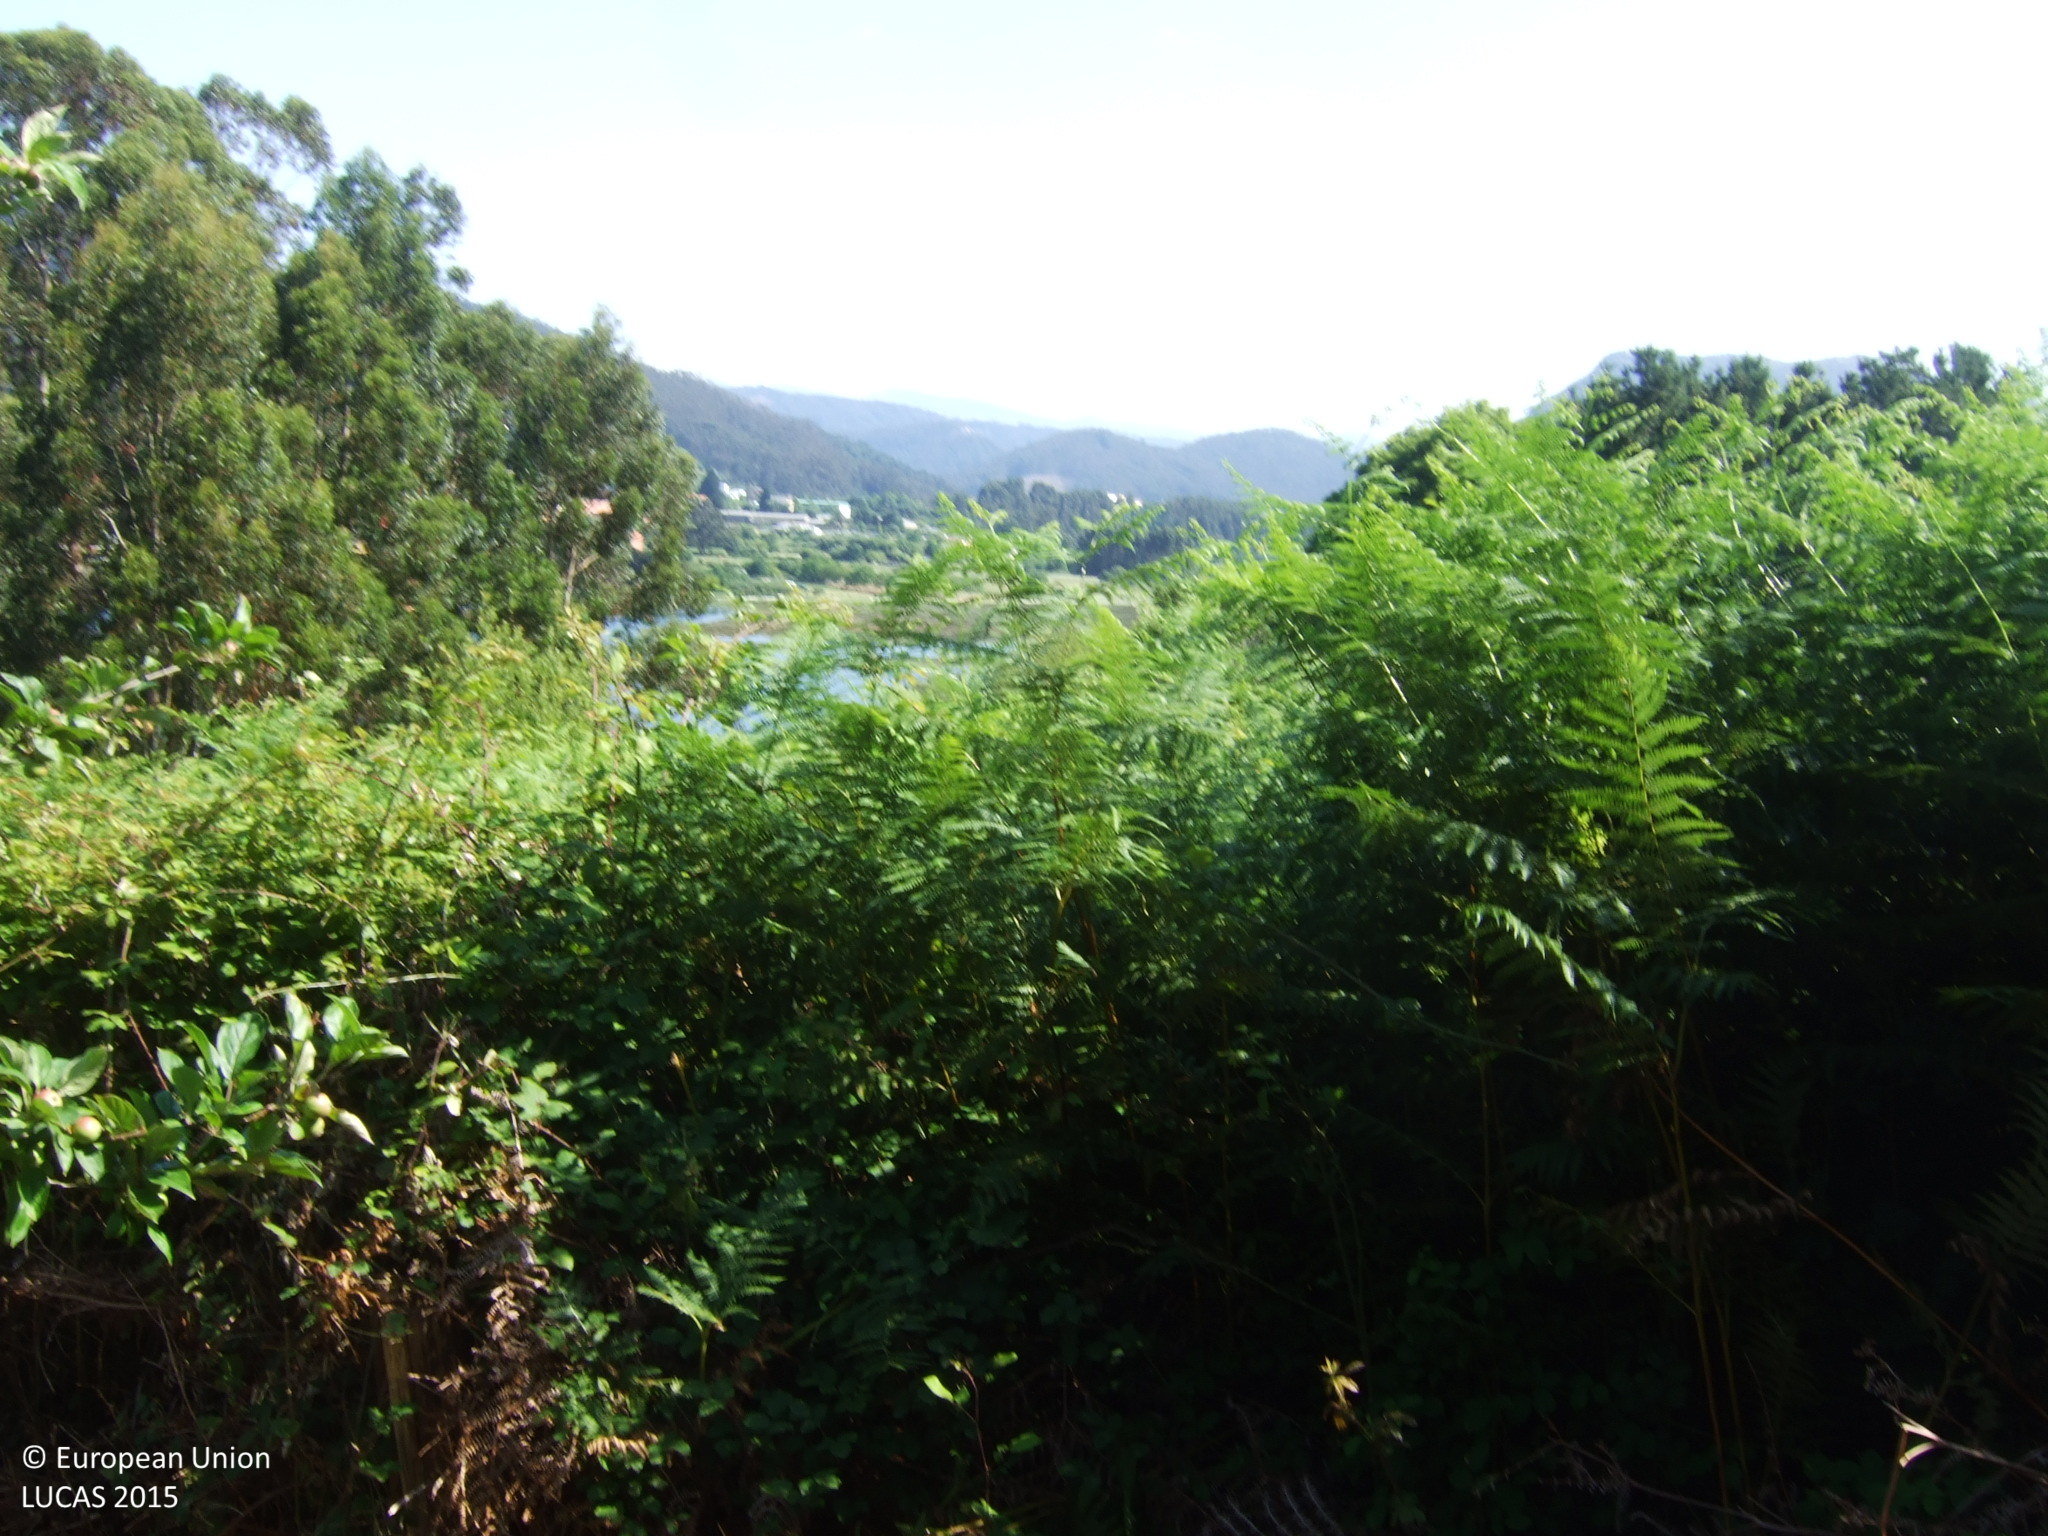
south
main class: Cropland
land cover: Apple fruit
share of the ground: 25 - 50 %
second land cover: Grassland without tree/shrub cover
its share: > 75 %
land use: Kitchen garden
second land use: Residential
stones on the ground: 10 - 25 %
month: June
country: ES
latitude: 43.6596
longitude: -7.6080
